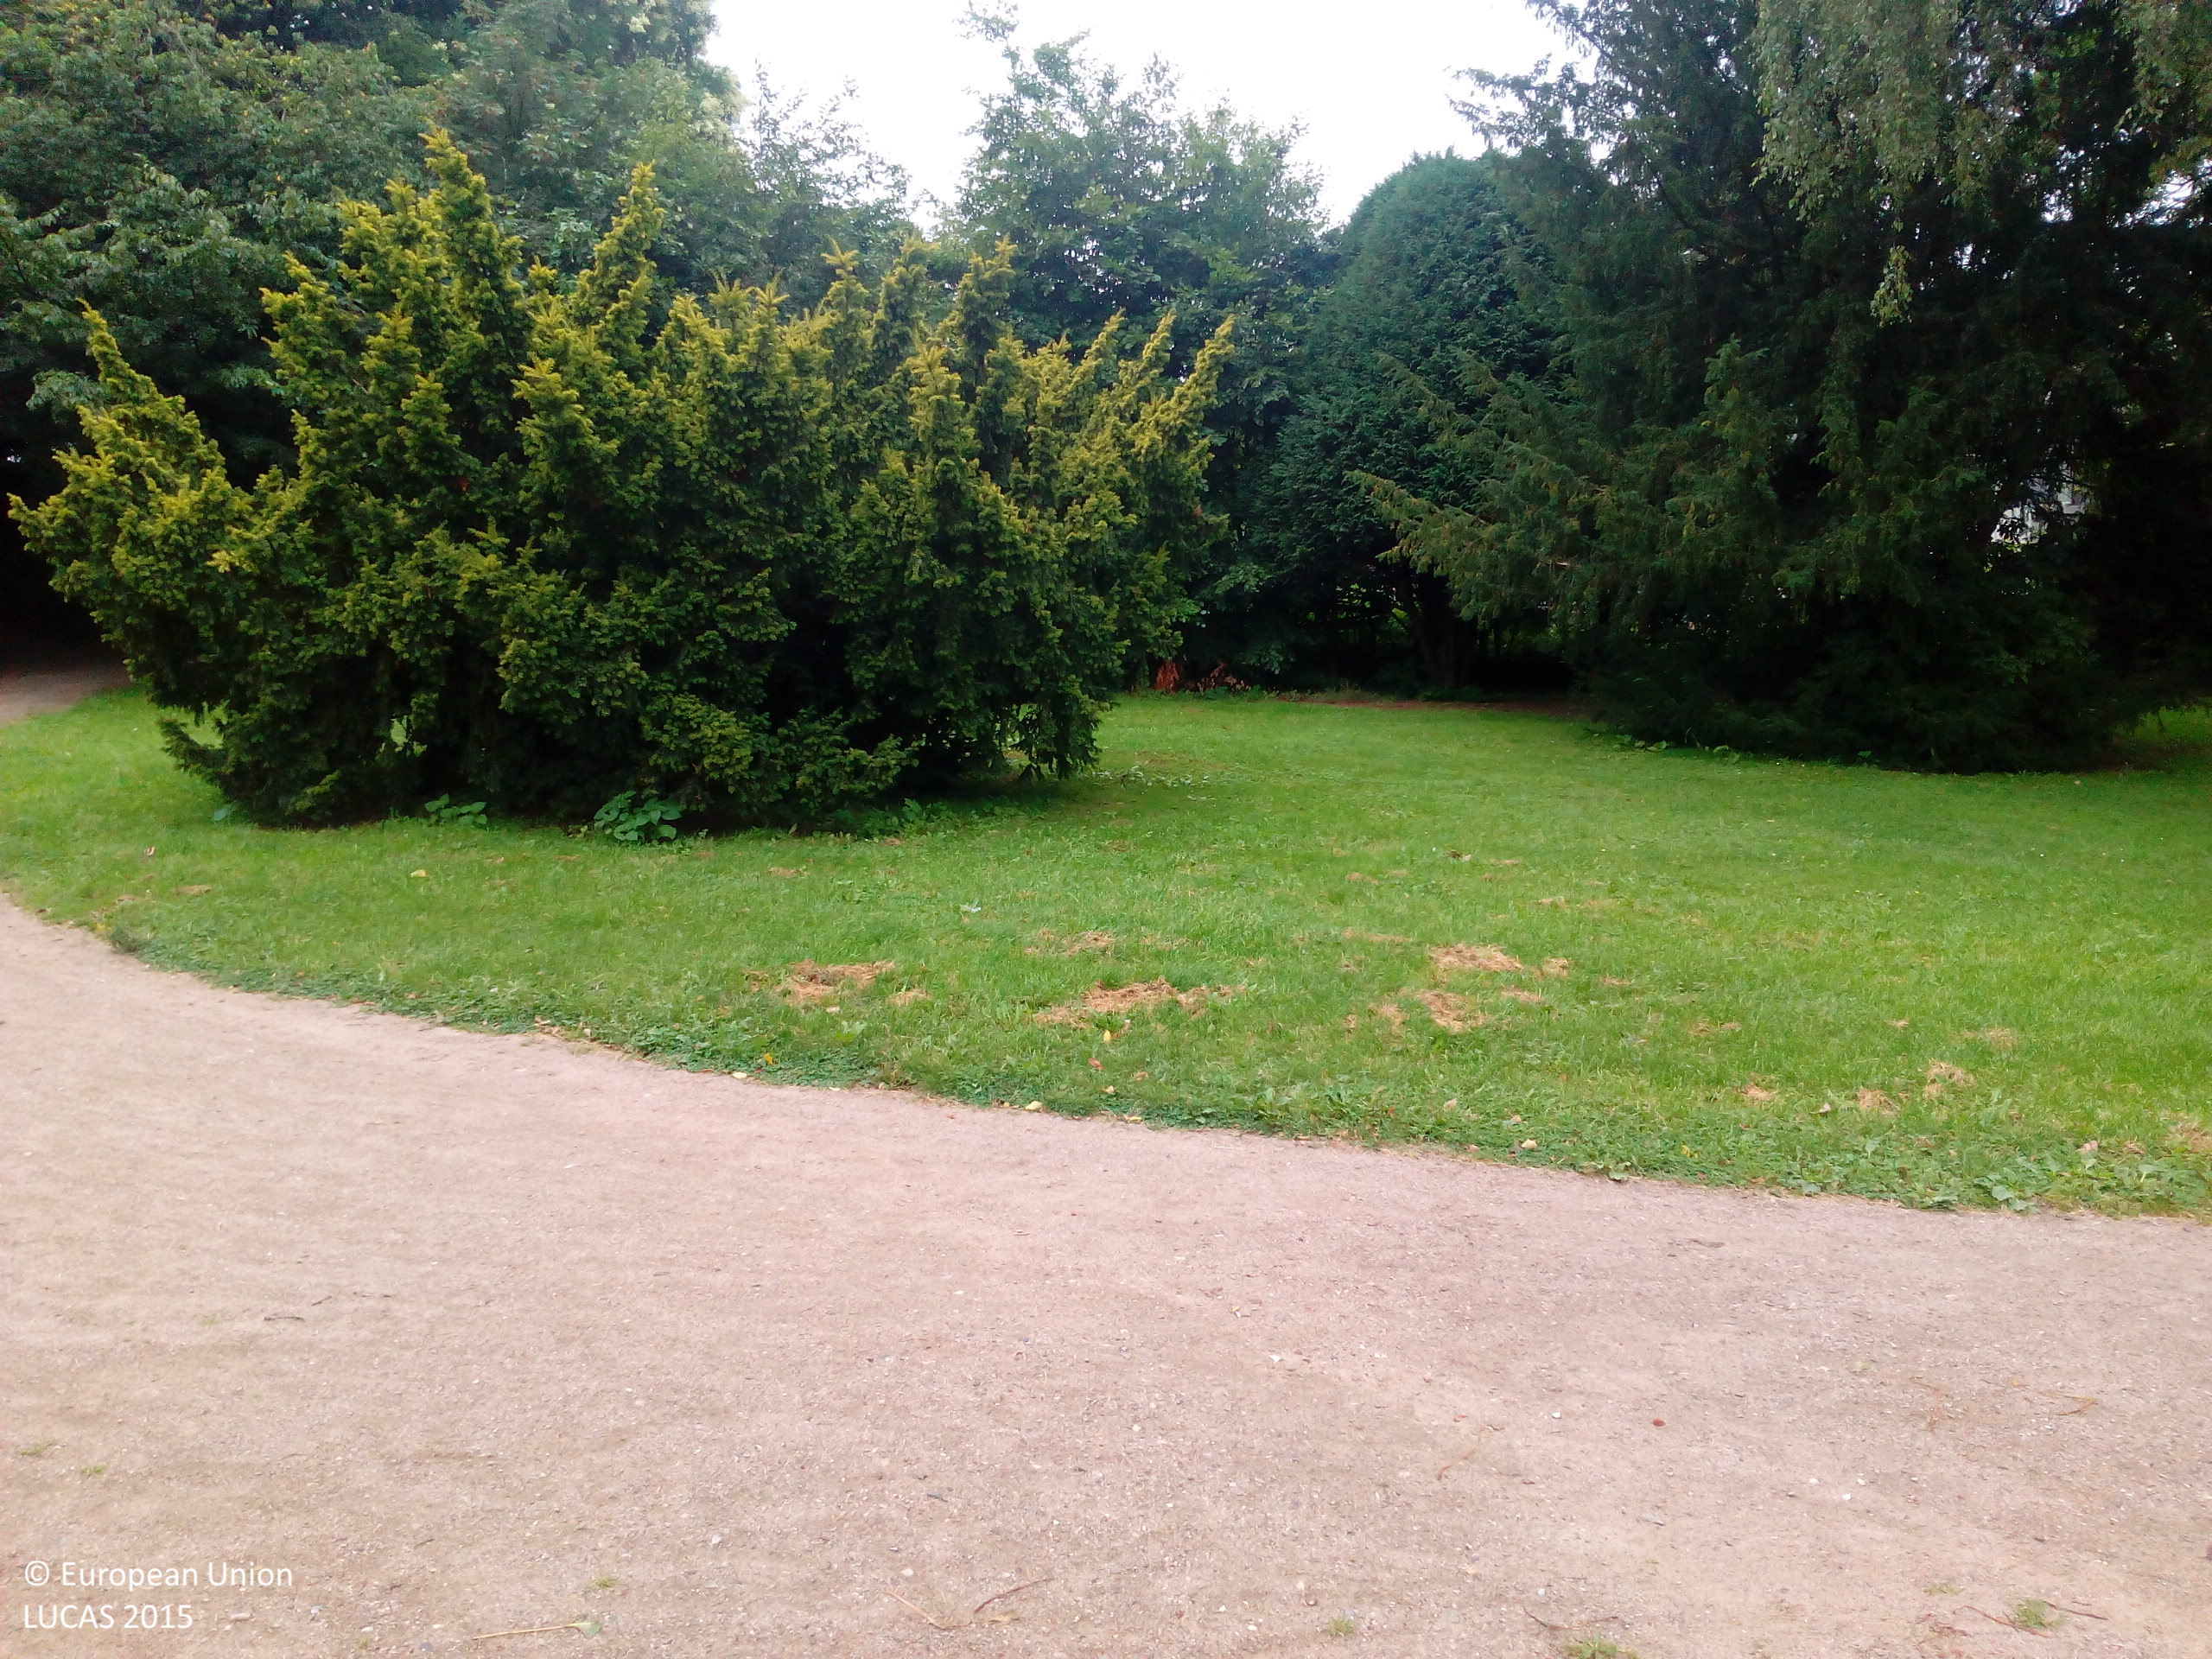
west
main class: Grassland
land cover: Spontaneously vegetated surfaces
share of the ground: > 75 %
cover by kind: herbaceous plants 95 %, shrubs 5 %
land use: Amenities, museums, leisure
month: August
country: DE
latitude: 53.5457
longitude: 9.9246
